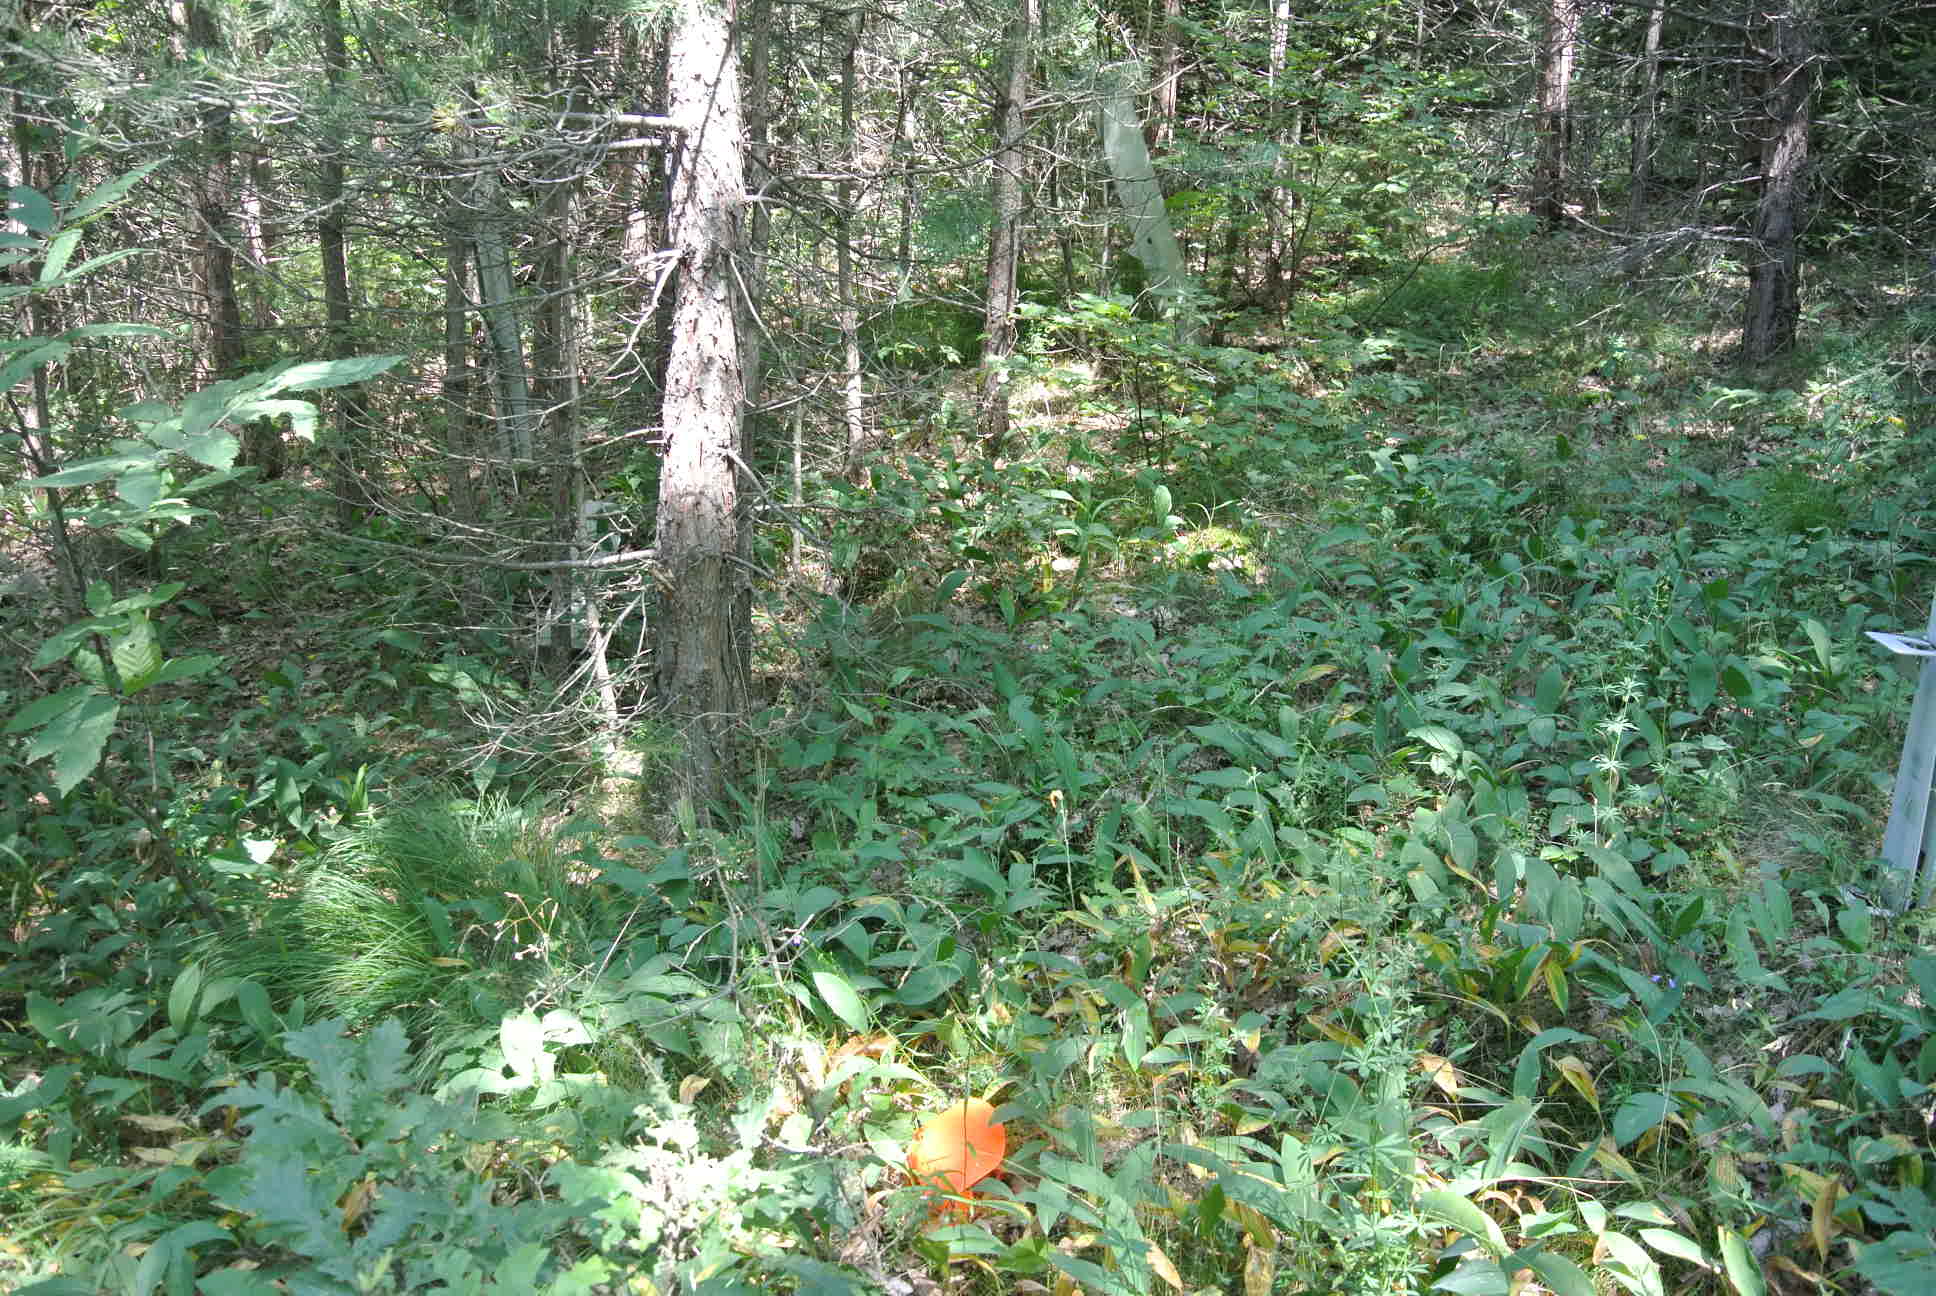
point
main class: Woodland
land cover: Pine dominated mixed woodland
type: alpine coniferous forest
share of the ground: > 75 %
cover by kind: coniferous forest trees 50 %, broadleaved forest trees 45 %, herbaceous plants 5 %
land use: Forestry
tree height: > 5 m
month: July
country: AT
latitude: 47.6938
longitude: 16.4129
